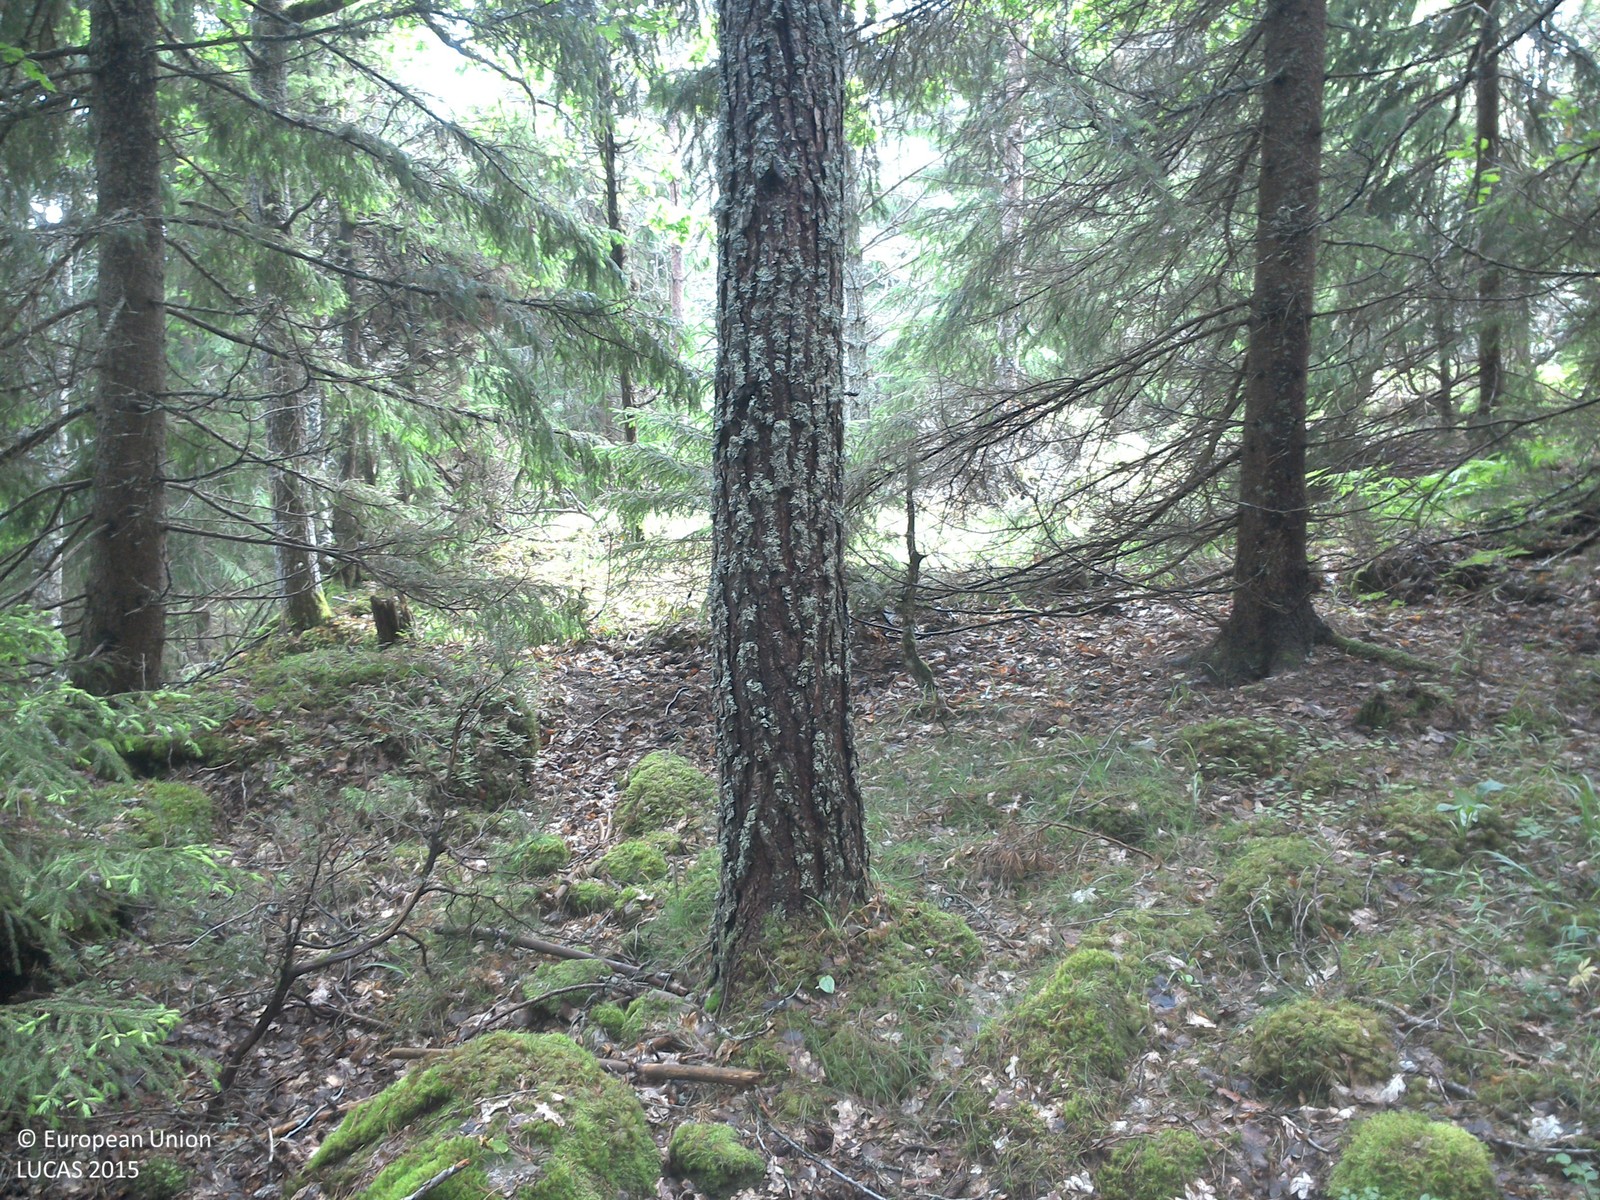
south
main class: Woodland
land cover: Spruce dominated coniferous woodland
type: boreal forest
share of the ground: > 75 %
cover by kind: coniferous forest trees 75 %, lichens and mosses 25 %
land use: Forestry
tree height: > 5 m
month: June
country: SE
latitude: 58.0859
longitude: 15.5752
